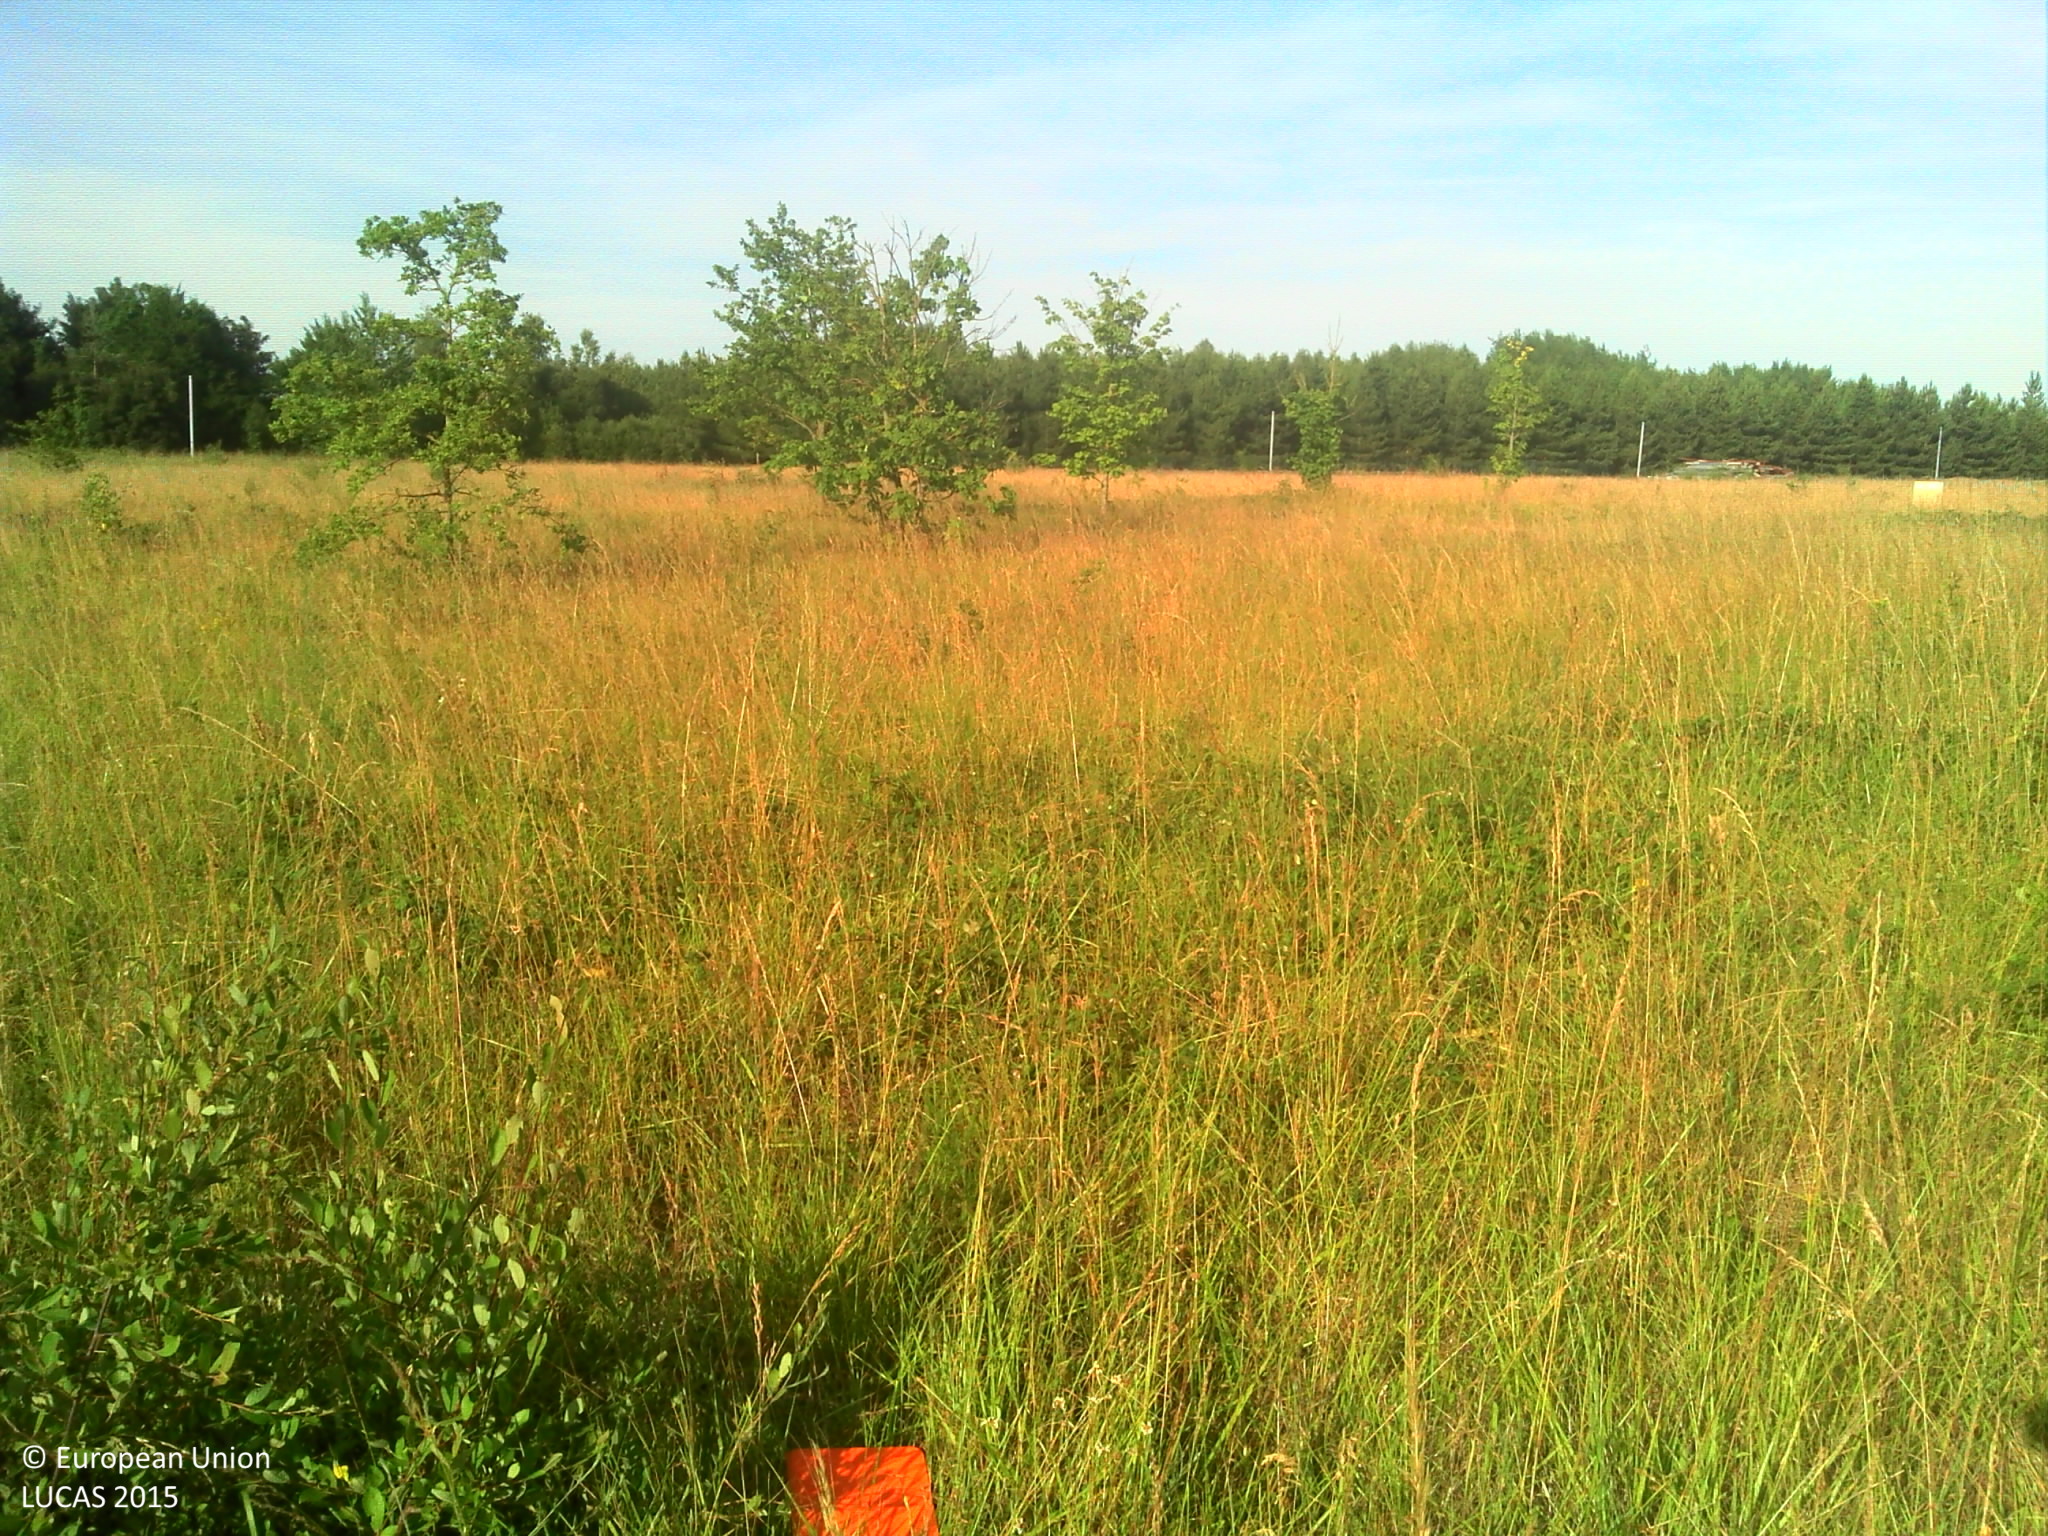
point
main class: Grassland
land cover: Grassland with sparse tree/shrub cover
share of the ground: > 75 %
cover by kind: herbaceous plants 95 %, broadleaved forest trees 5 %
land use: Construction
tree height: > 5 m
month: June
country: FR
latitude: 47.3994
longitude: 1.4132
